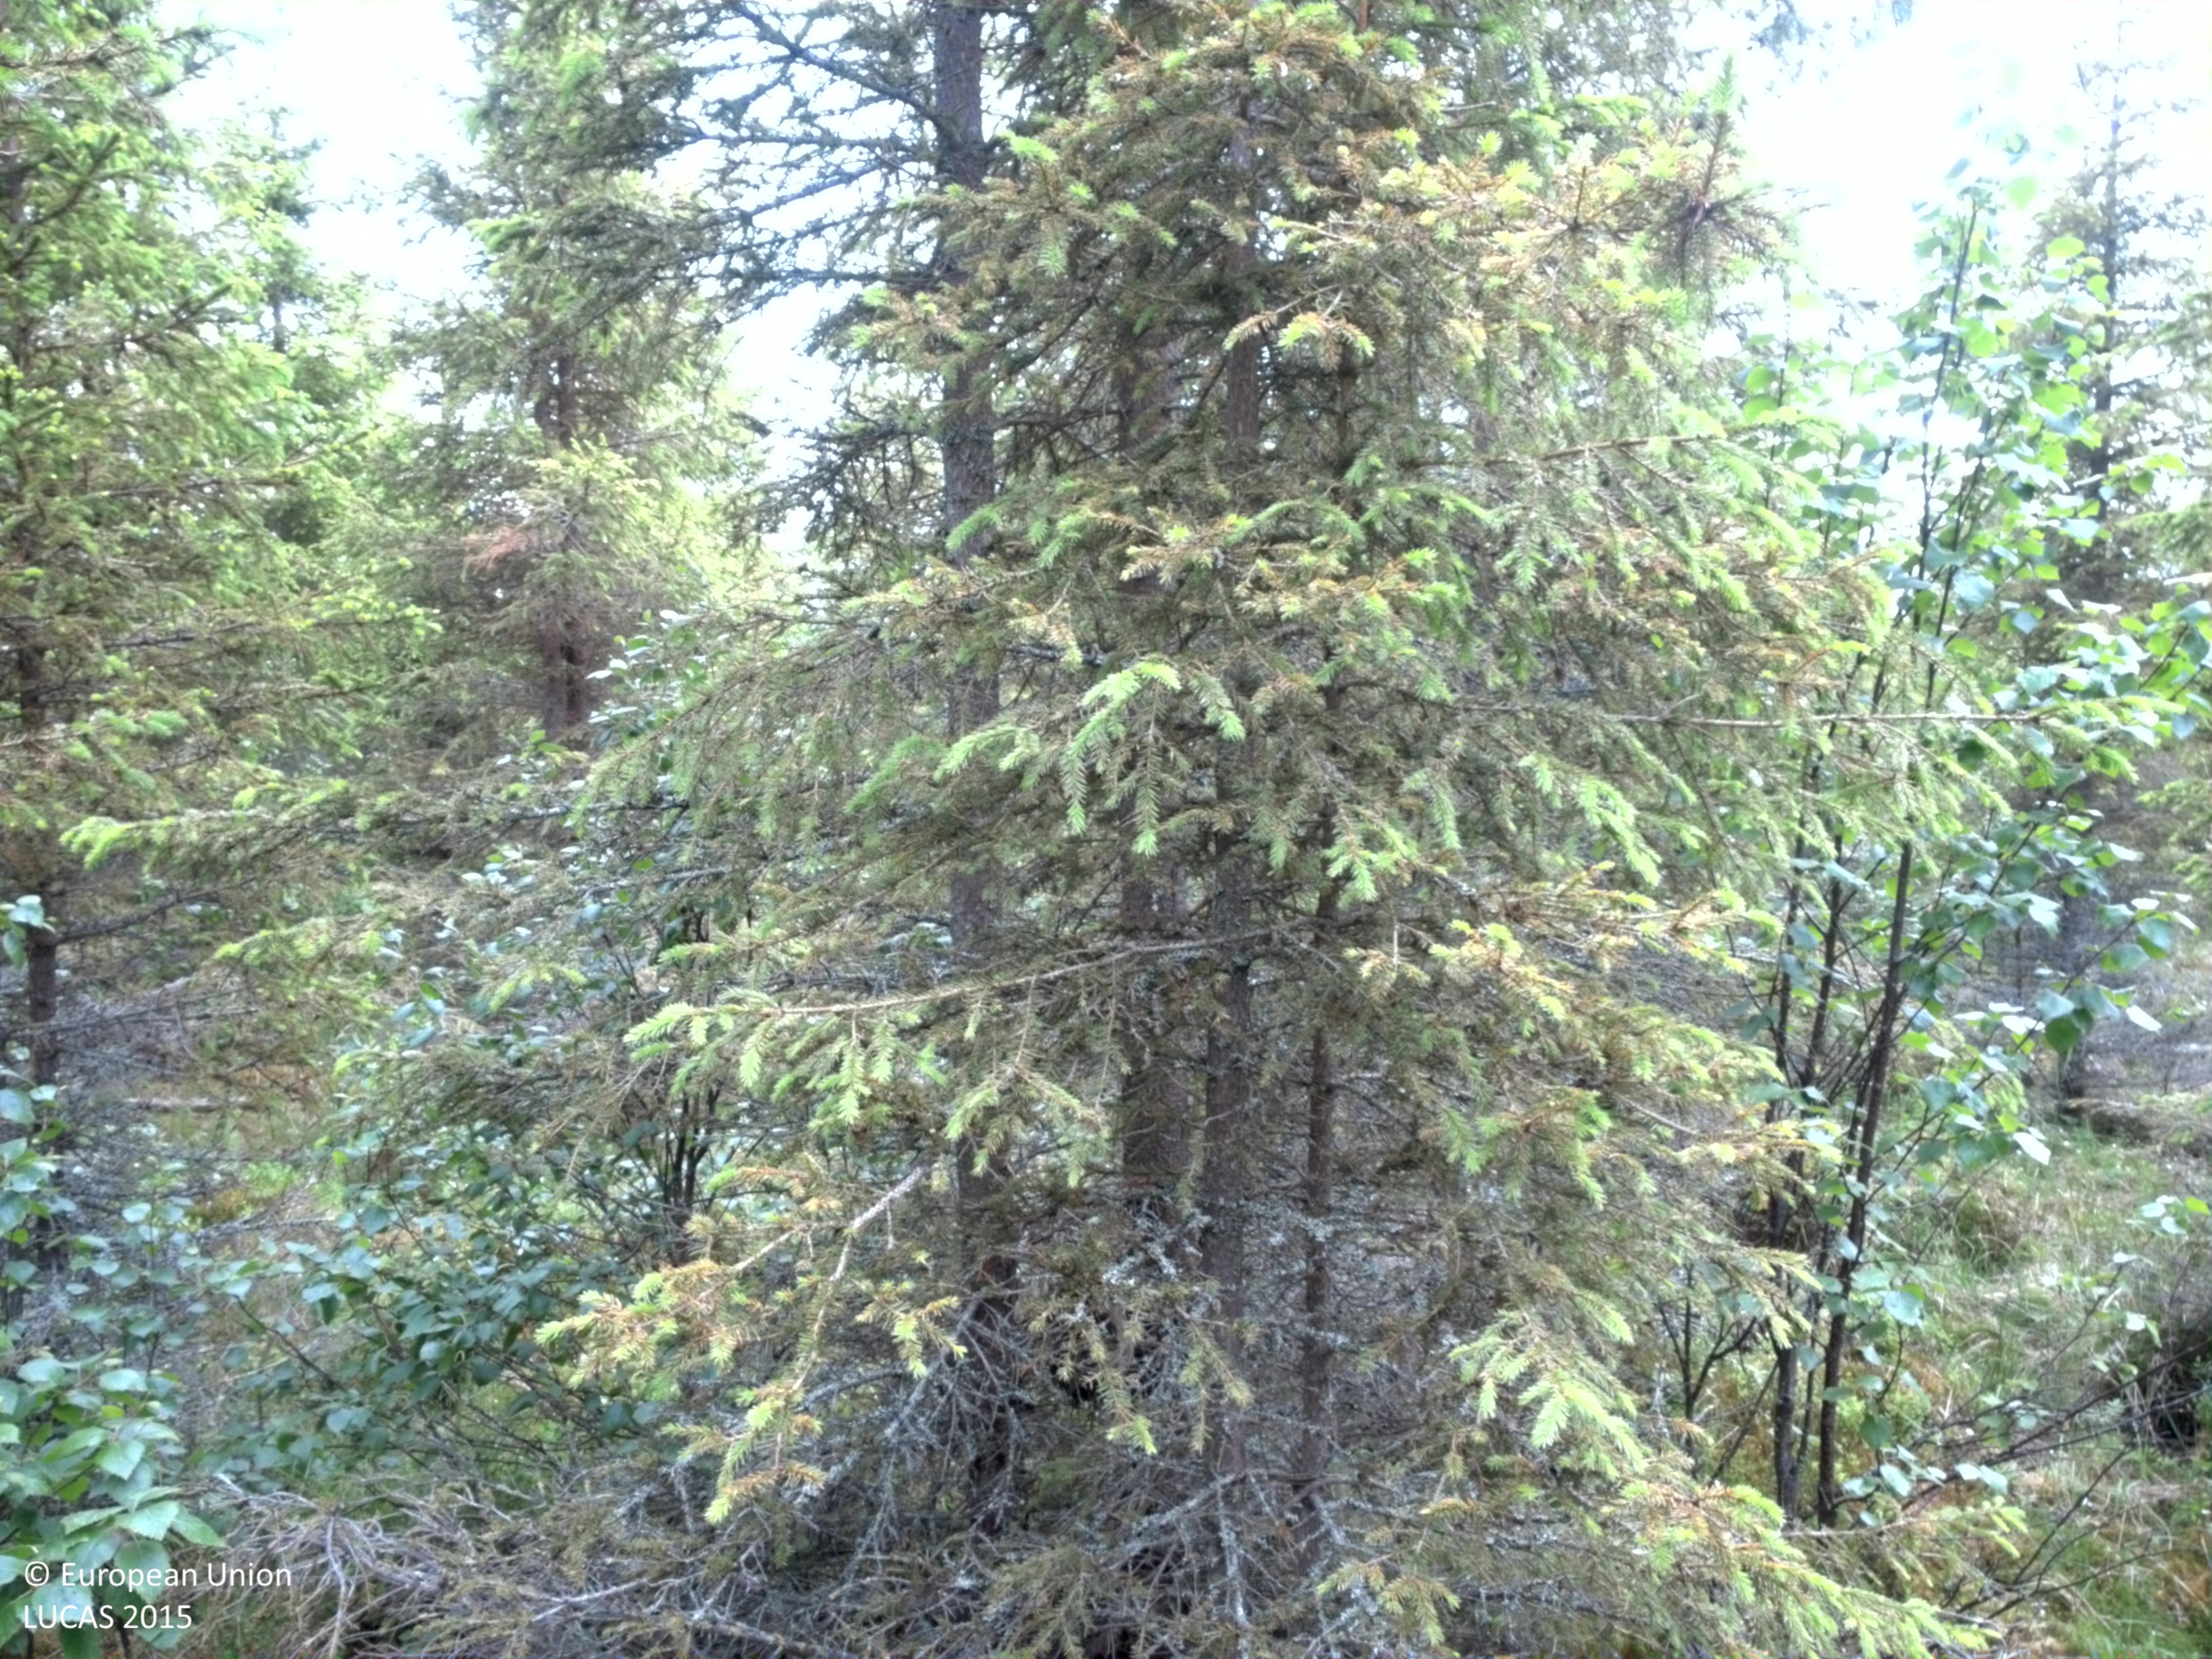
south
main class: Woodland
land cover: Spruce dominated mixed woodland
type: boreal forest
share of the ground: 50 - 75 %
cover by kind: coniferous forest trees 45 %, broadleaved forest trees 15 %, shrubs 15 %, herbaceous plants 15 %, lichens and mosses 10 %
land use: Forestry
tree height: > 5 m
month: July
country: SE
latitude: 64.4438
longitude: 18.1330
